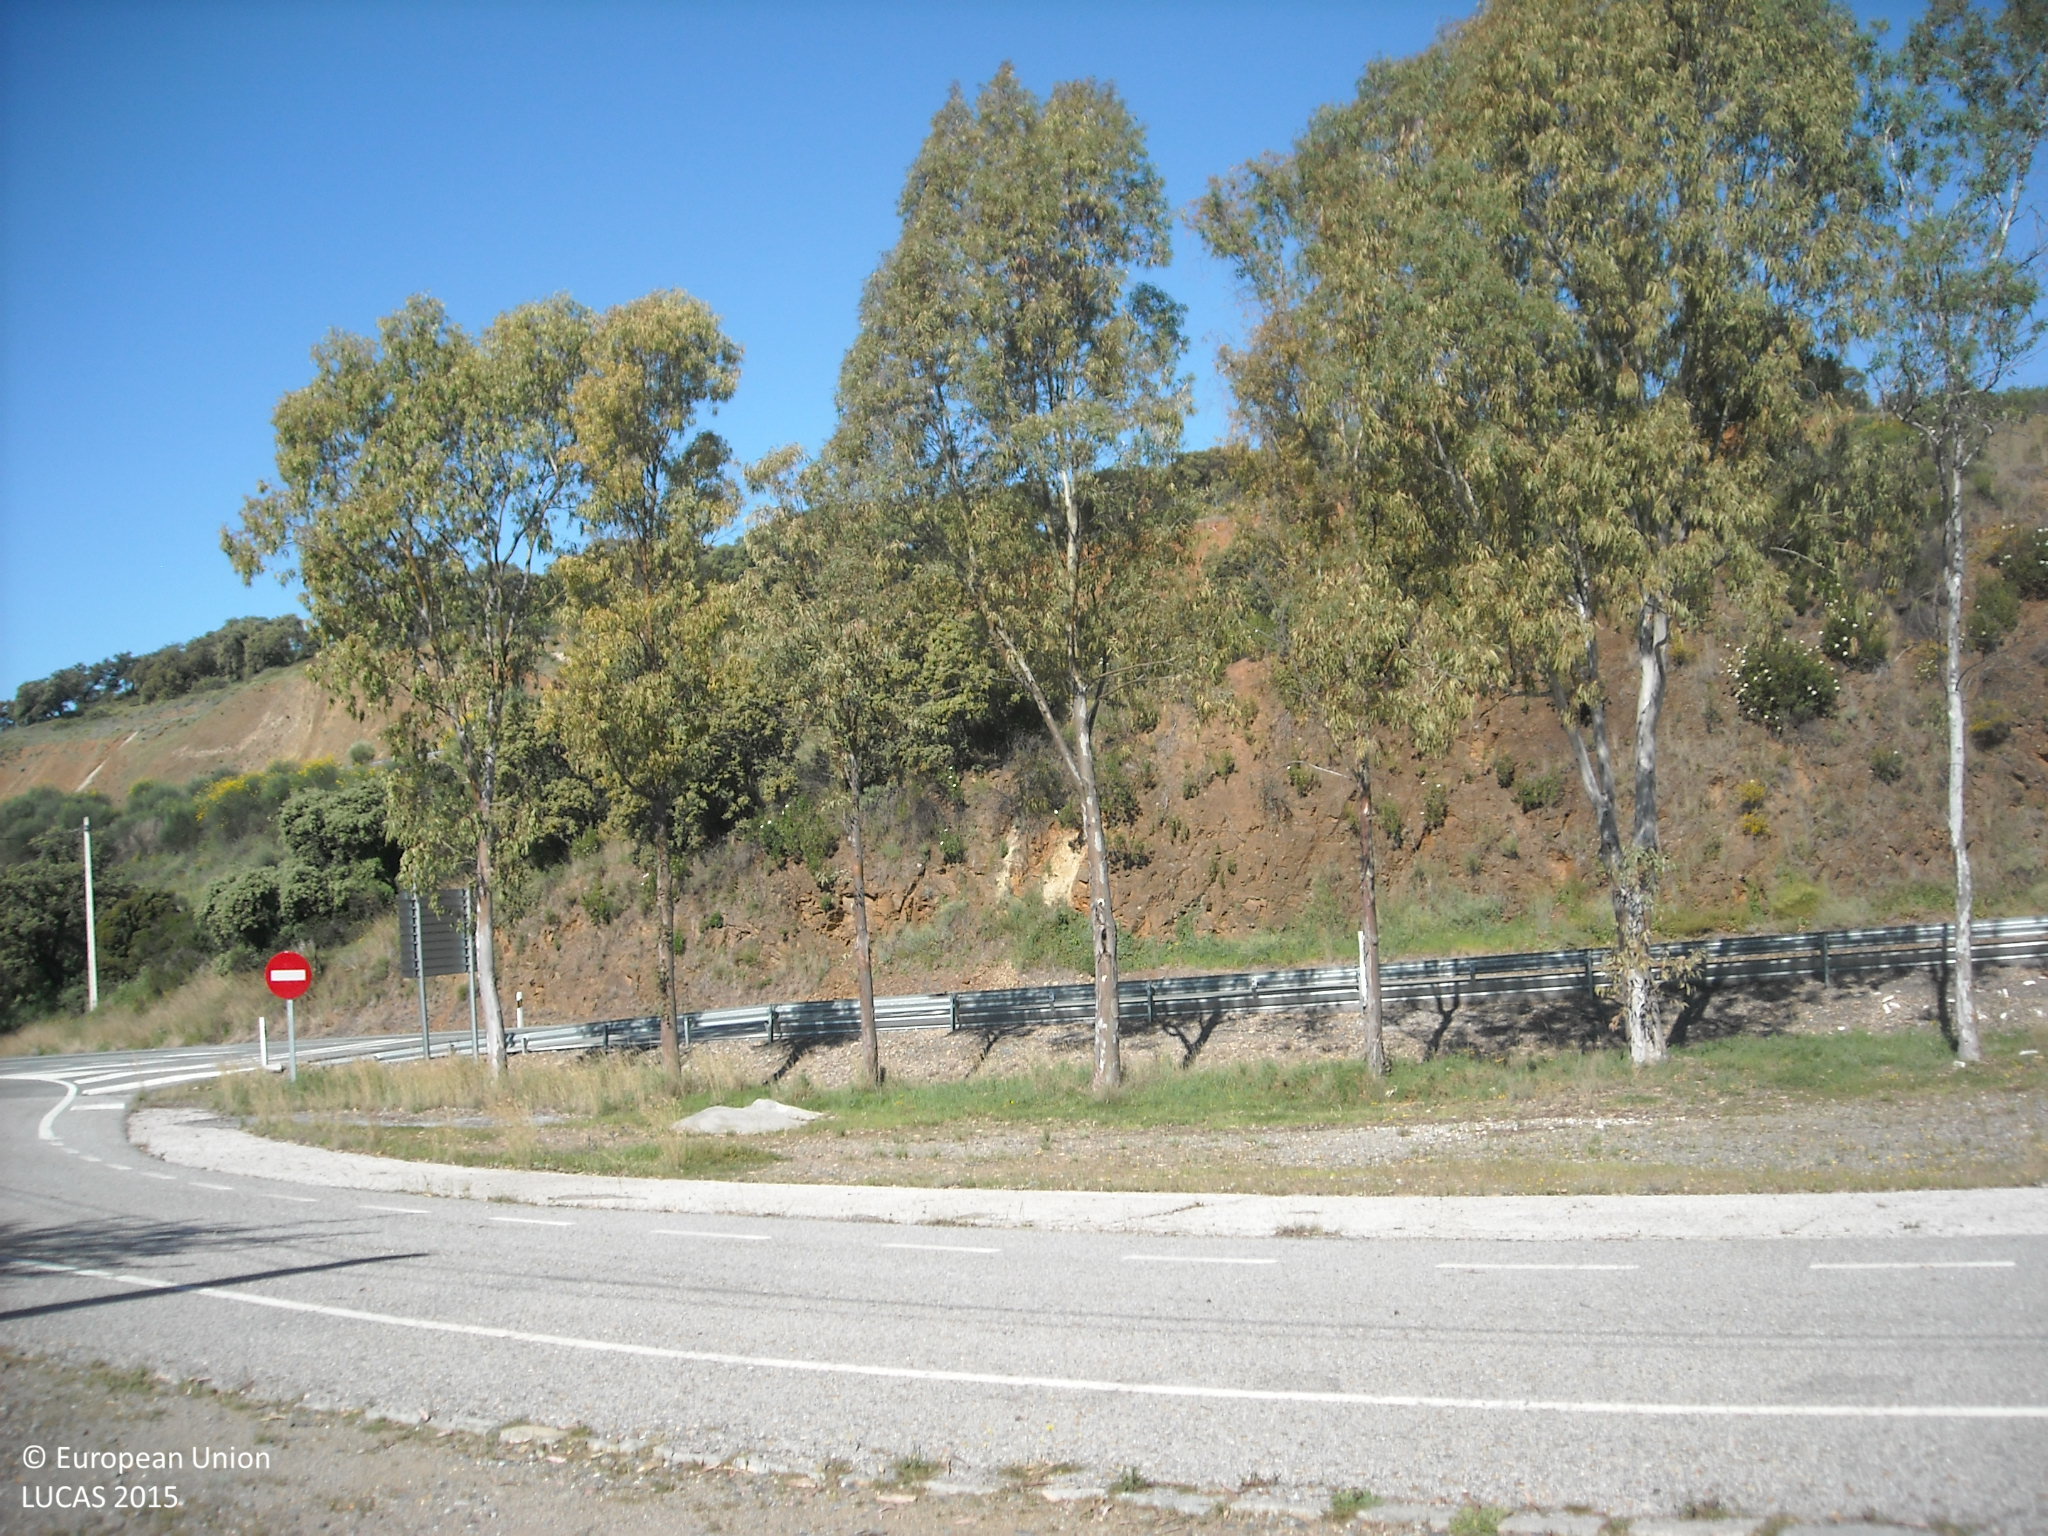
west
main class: Woodland
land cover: Broadleaved woodland
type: broadleaved evergreen forest
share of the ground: 25 - 50 %
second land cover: Grassland without tree/shrub cover
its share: > 75 %
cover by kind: herbaceous plants 60 %, broadleaved forest trees 40 %
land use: Forestry
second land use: Agriculture (excluding fallow land and kitchen gardens)
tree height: > 5 m
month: April
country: ES
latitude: 37.6997
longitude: -6.1720
